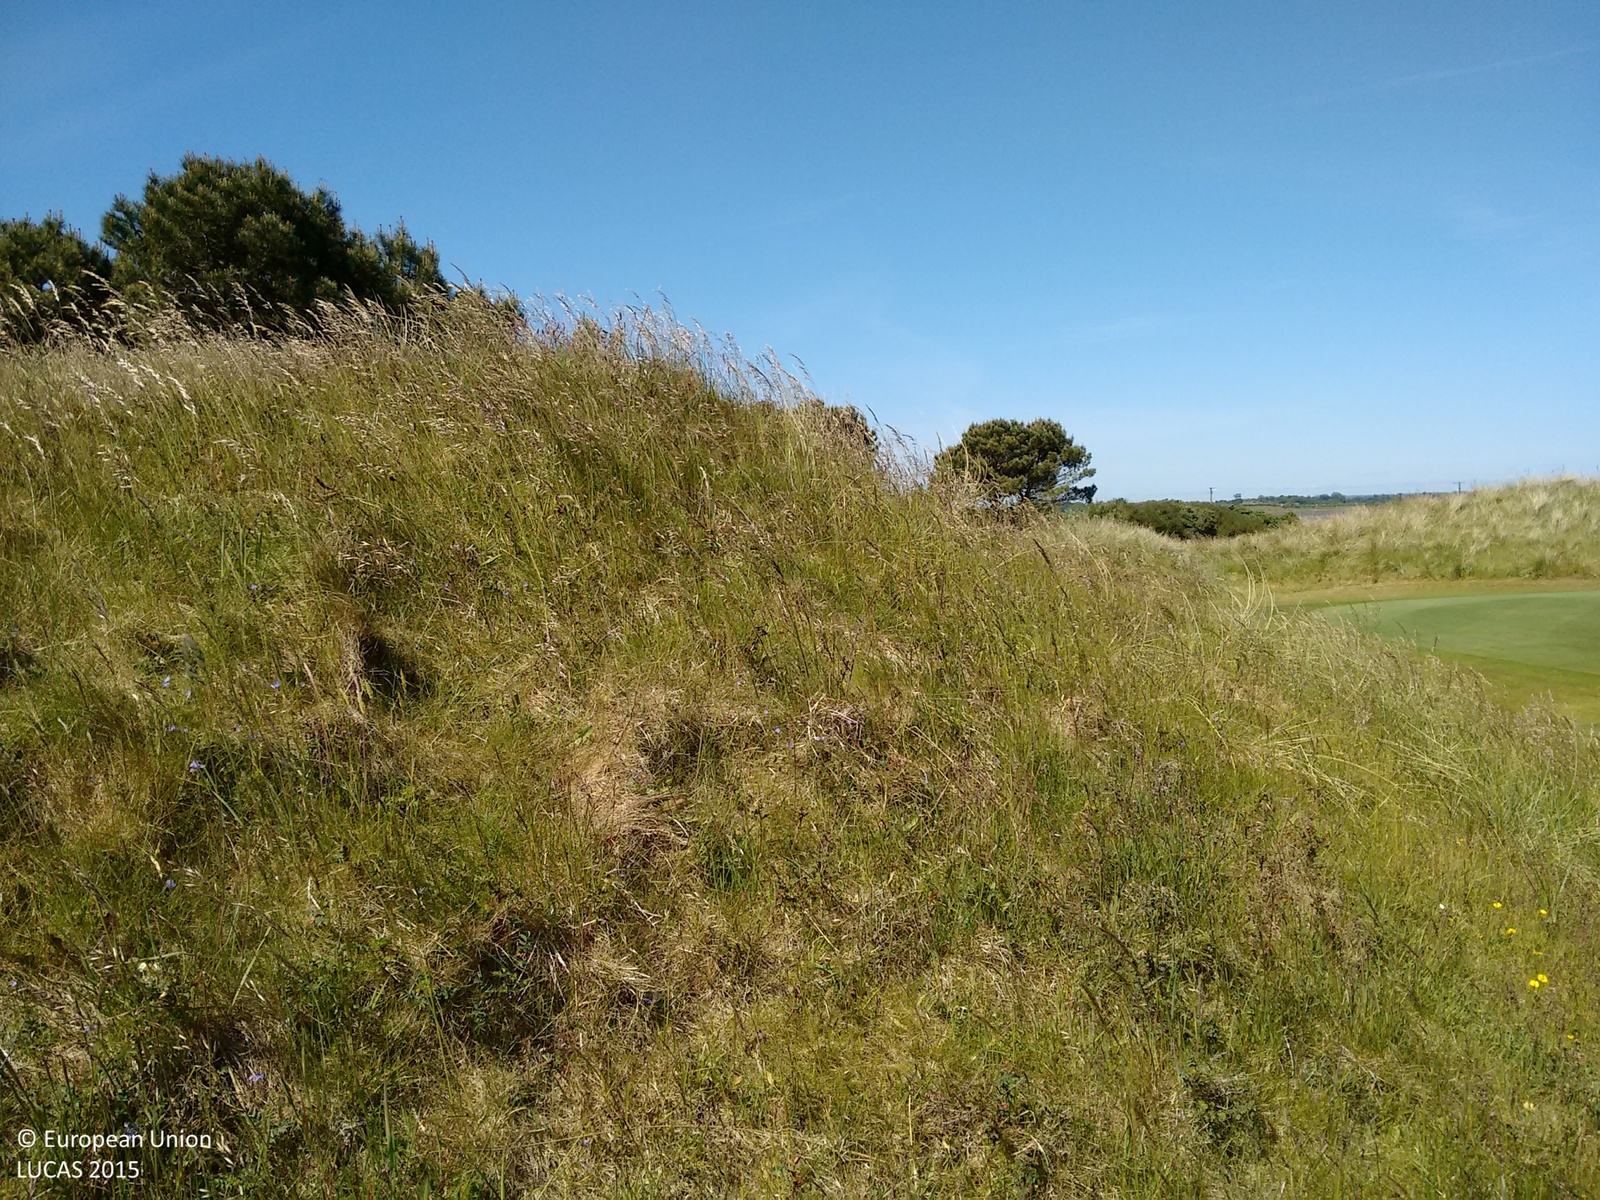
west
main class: Grassland
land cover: Grassland without tree/shrub cover
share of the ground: > 75 %
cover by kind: herbaceous plants 95 %, unconsolidated bare surface 5 %
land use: Sport
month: June
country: IE
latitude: 53.4670
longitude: -6.1287
